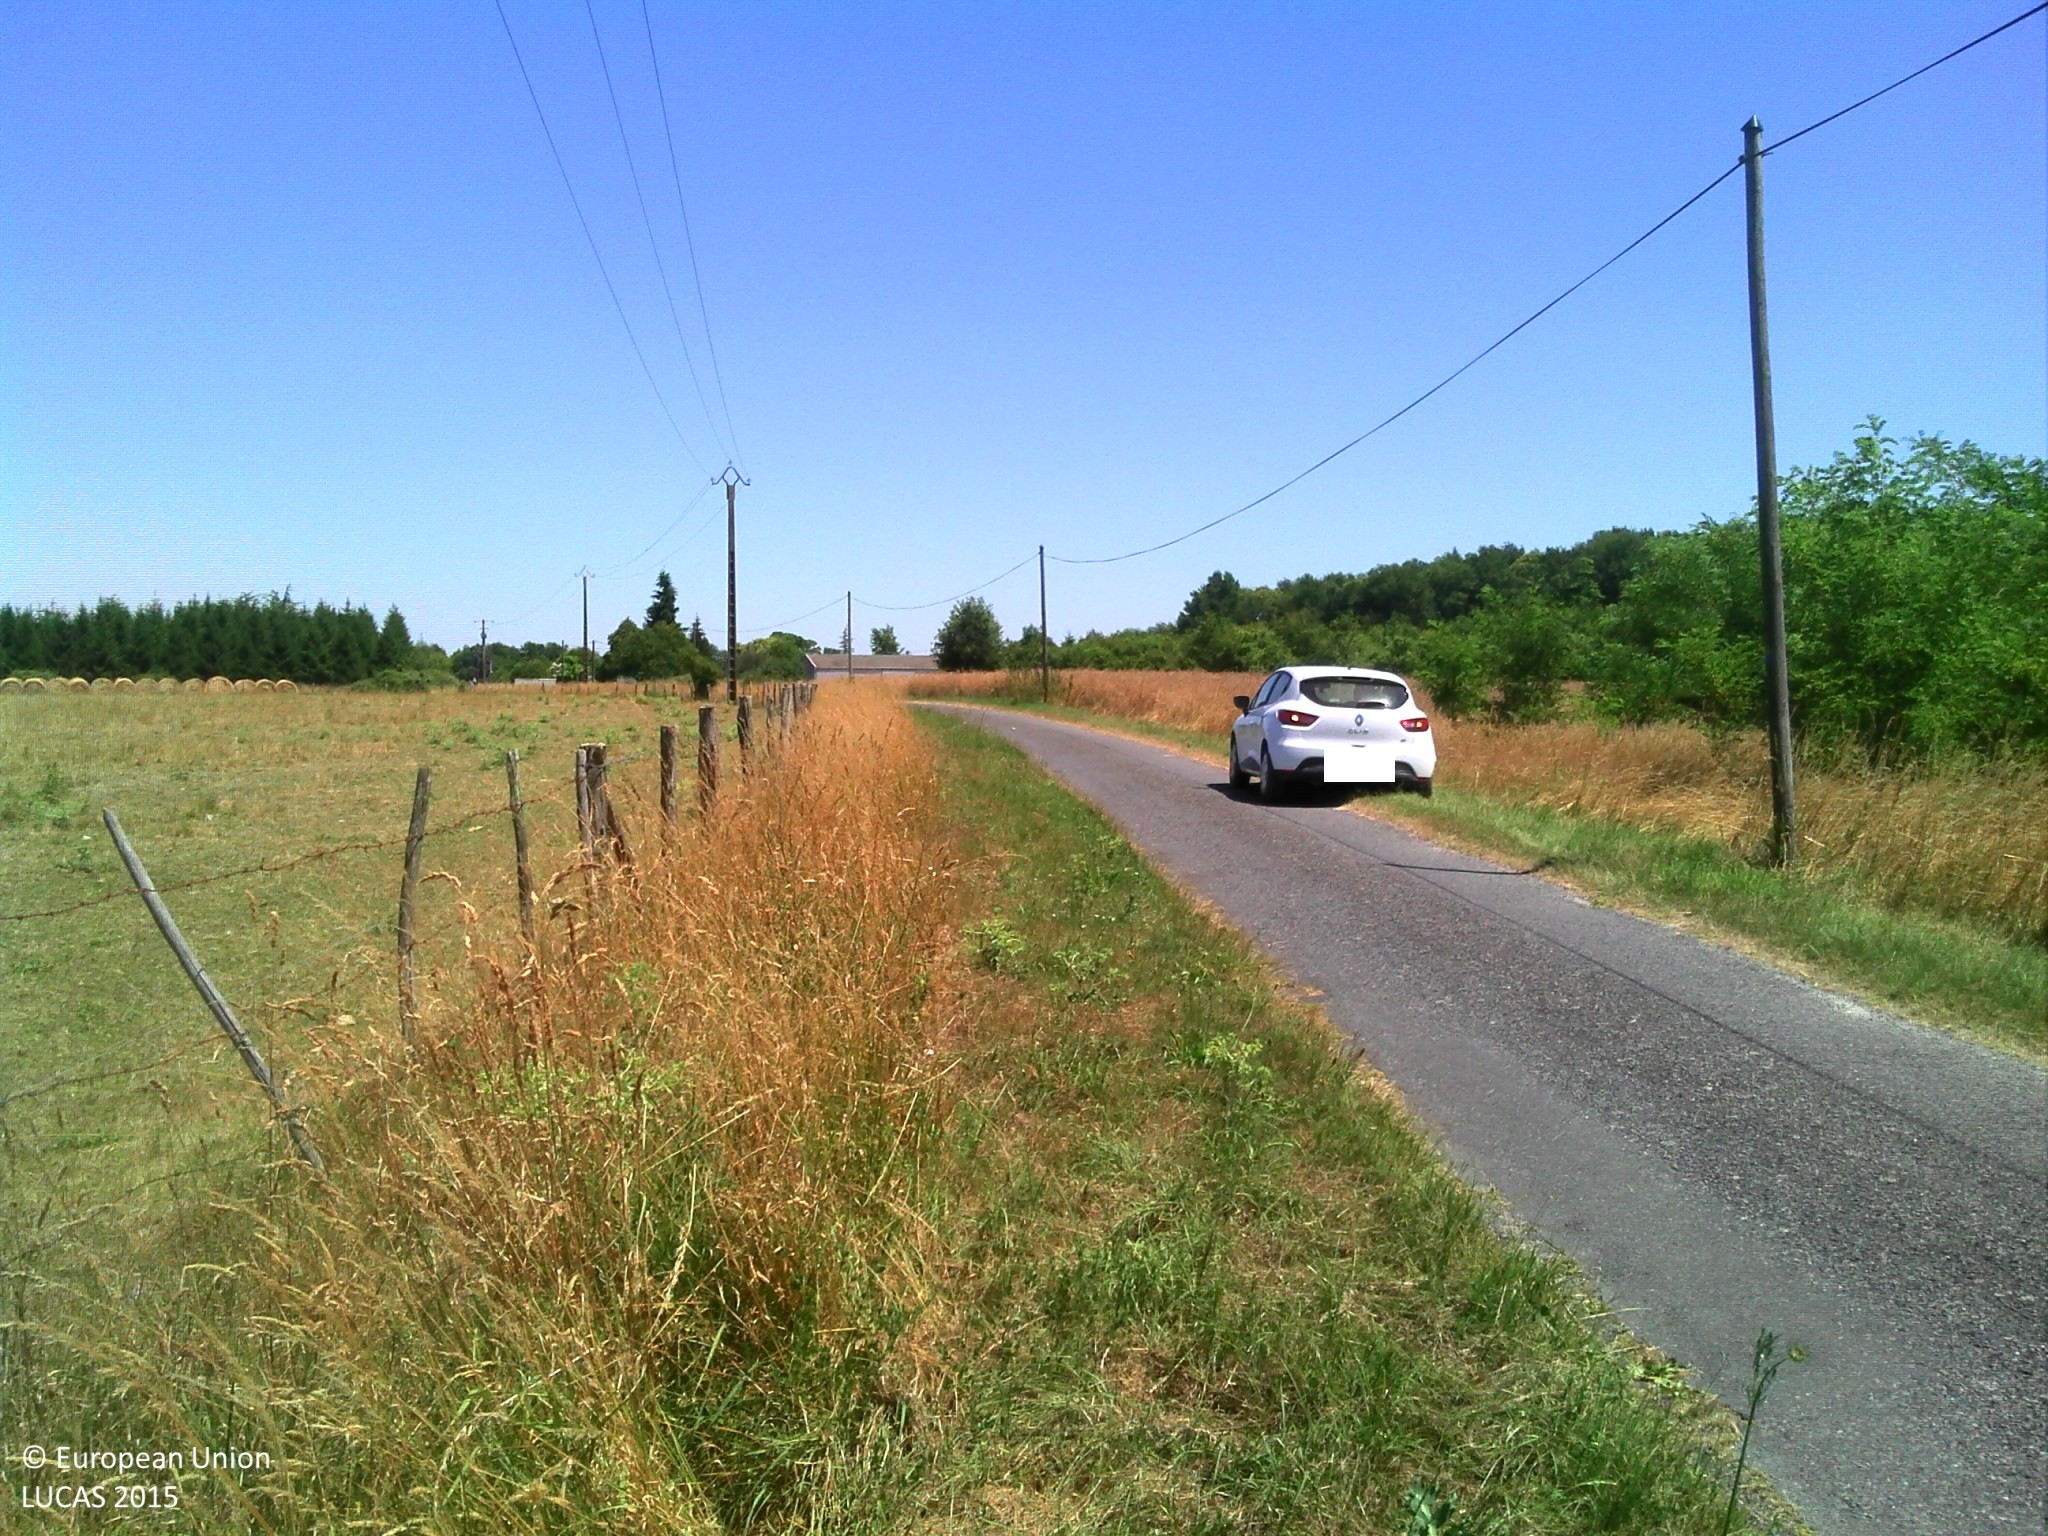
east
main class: Grassland
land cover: Grassland without tree/shrub cover
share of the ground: > 75 %
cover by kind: herbaceous plants 100 %
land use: Agriculture (excluding fallow land and kitchen gardens)
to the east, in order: Grassland without tree/shrub cover; Fences; Grassland without tree/shrub cover; Fences; Grass margins; Paved roads, cycling and walking lanes; Grass margins; Electric lines; Fences; Grassland with sparse tree/shrub cover
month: June
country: FR
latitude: 47.3869
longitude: 0.4006
